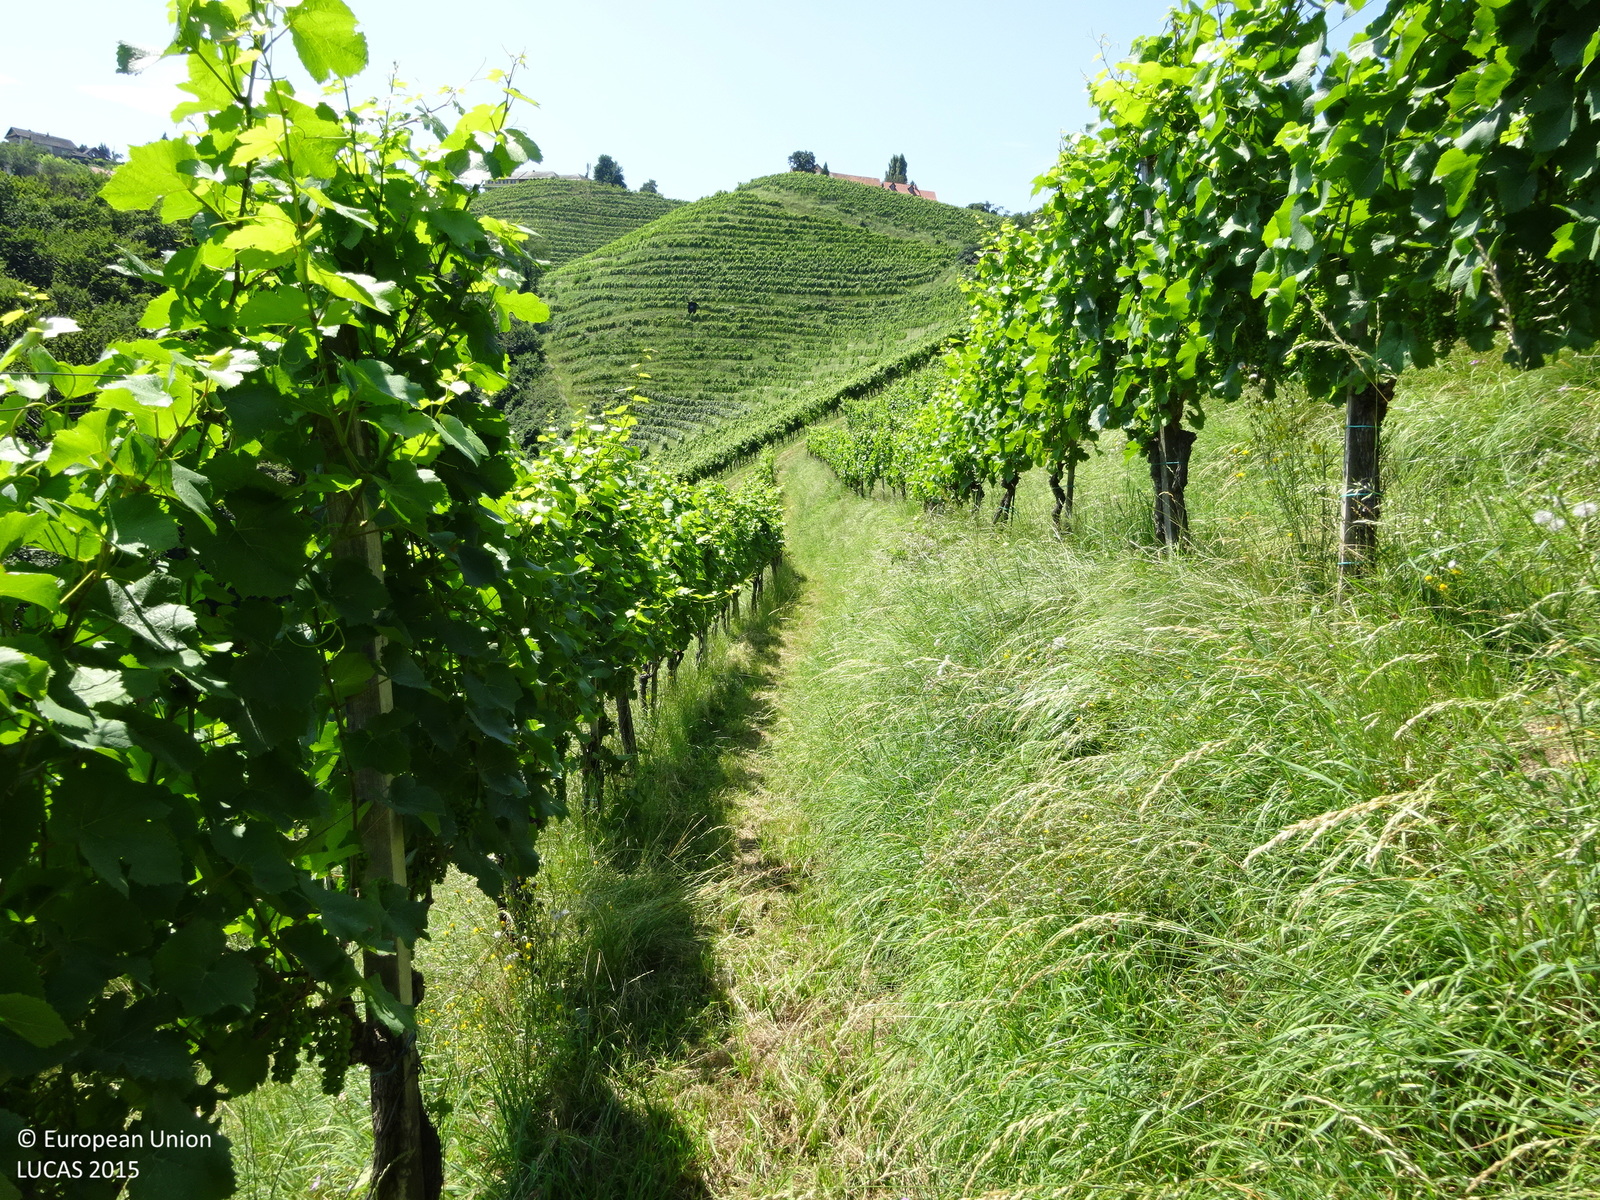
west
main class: Cropland
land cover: Vineyards
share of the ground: 25 - 50 %
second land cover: Grassland without tree/shrub cover
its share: 50 - 75 %
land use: Agriculture (excluding fallow land and kitchen gardens)
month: July
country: AT
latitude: 46.7892
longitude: 15.4619
